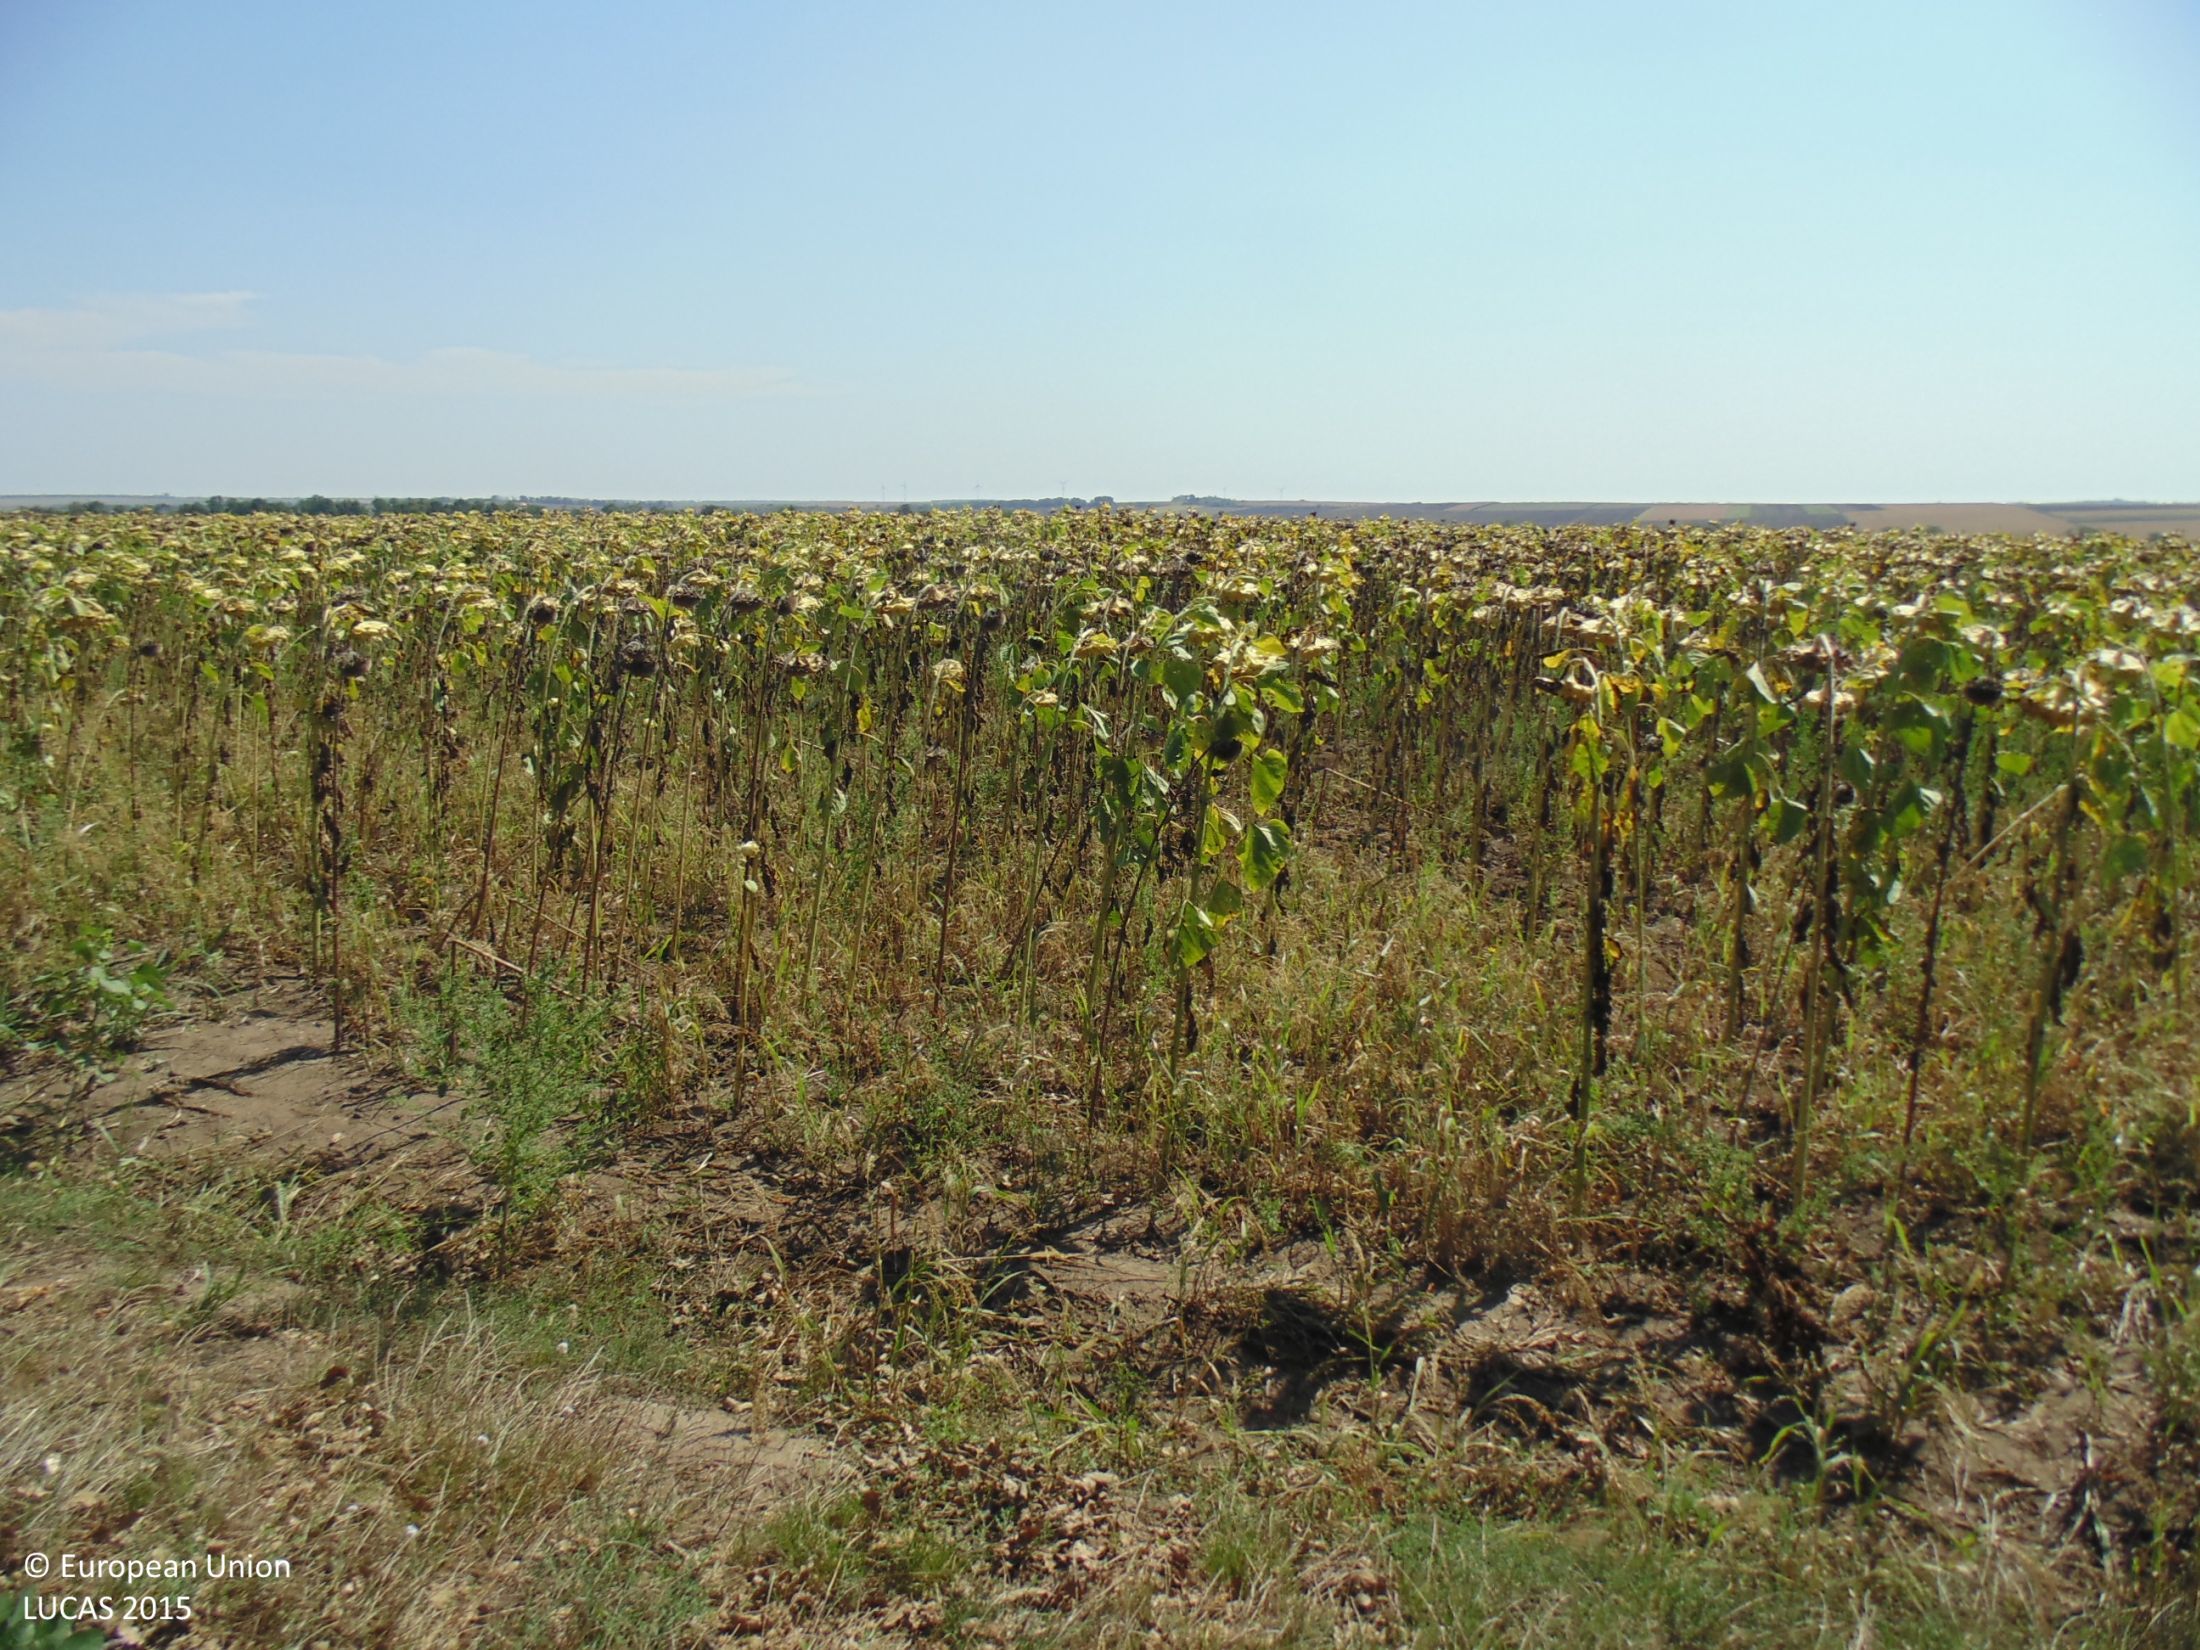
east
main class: Woodland
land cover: Broadleaved woodland
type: mesophytic deciduous forest
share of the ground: > 75 %
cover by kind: broadleaved forest trees 90 %, shrubs 5 %, unconsolidated bare surface 5 %
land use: Forestry
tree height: > 5 m
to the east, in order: Tracks; Sunflower
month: August
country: BG
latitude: 43.6364
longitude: 27.4222
